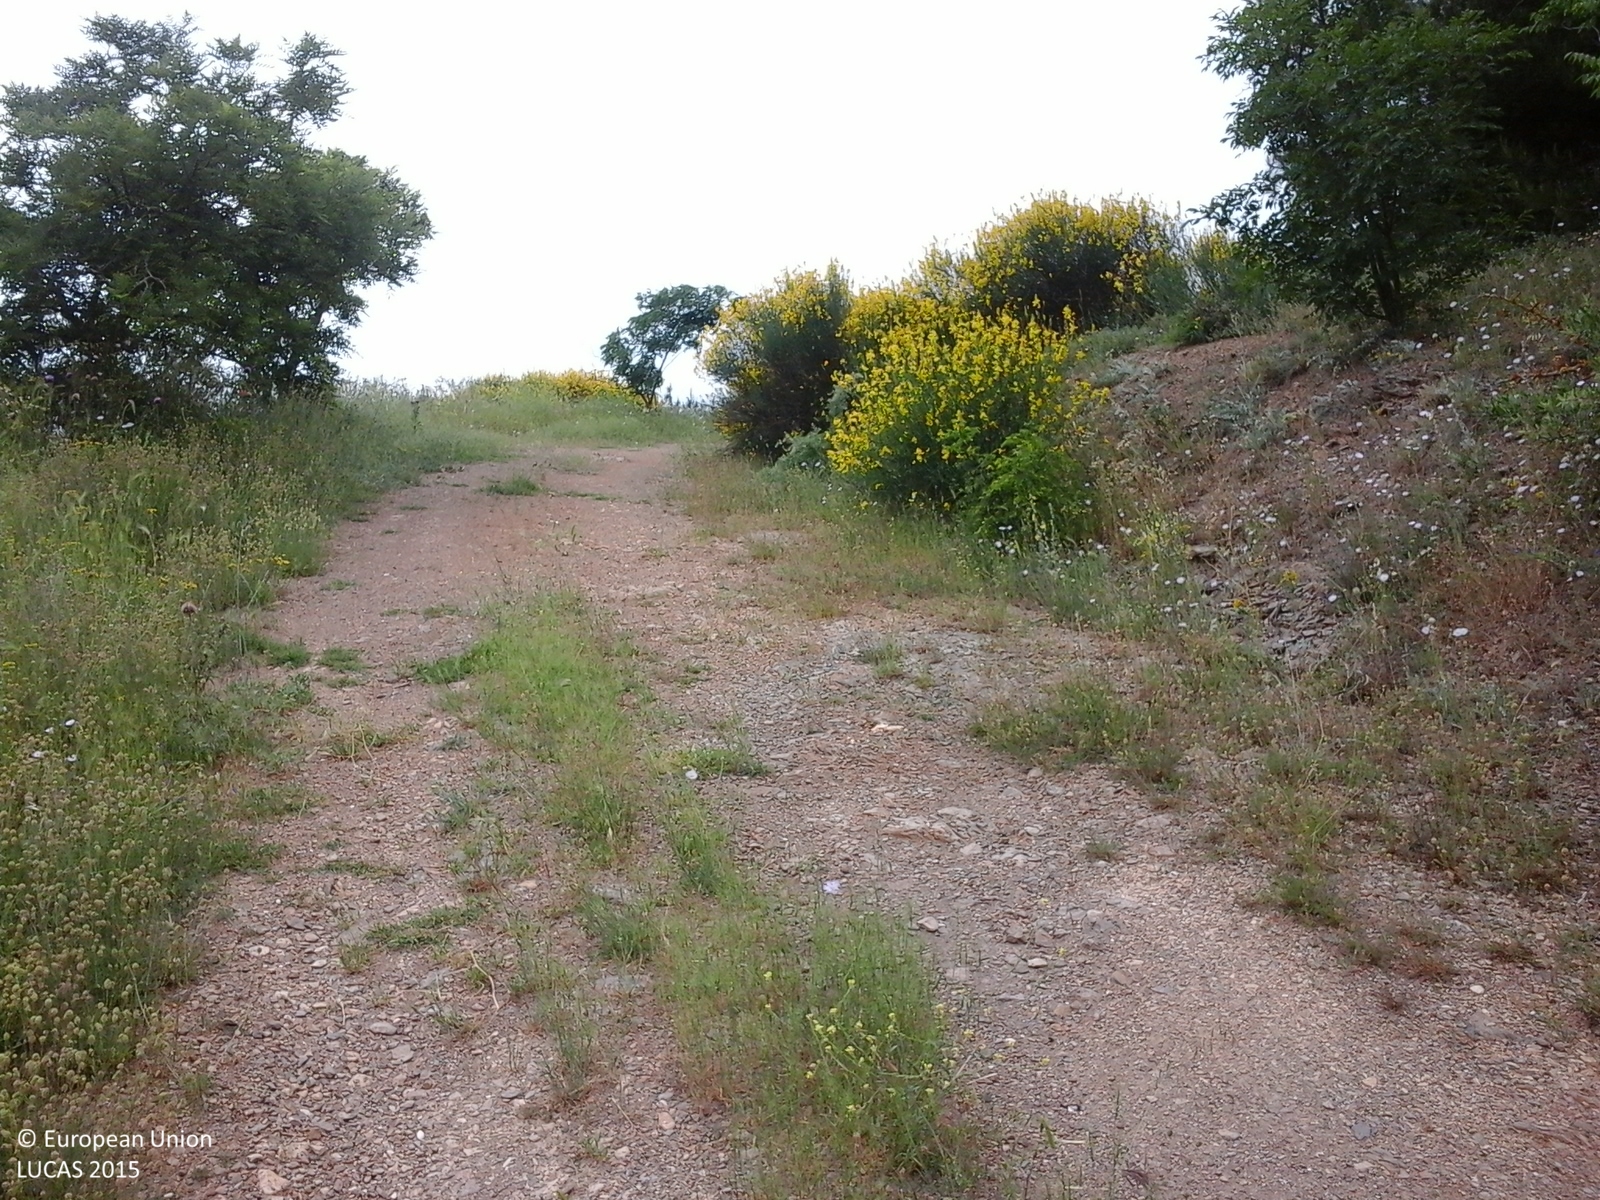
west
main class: Shrubland
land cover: Shrubland without tree cover
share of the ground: > 75 %
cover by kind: shrubs 95 %, herbaceous plants 5 %
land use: Semi-natural and natural areas not in use
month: May
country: GR
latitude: 40.7403
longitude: 22.9519
